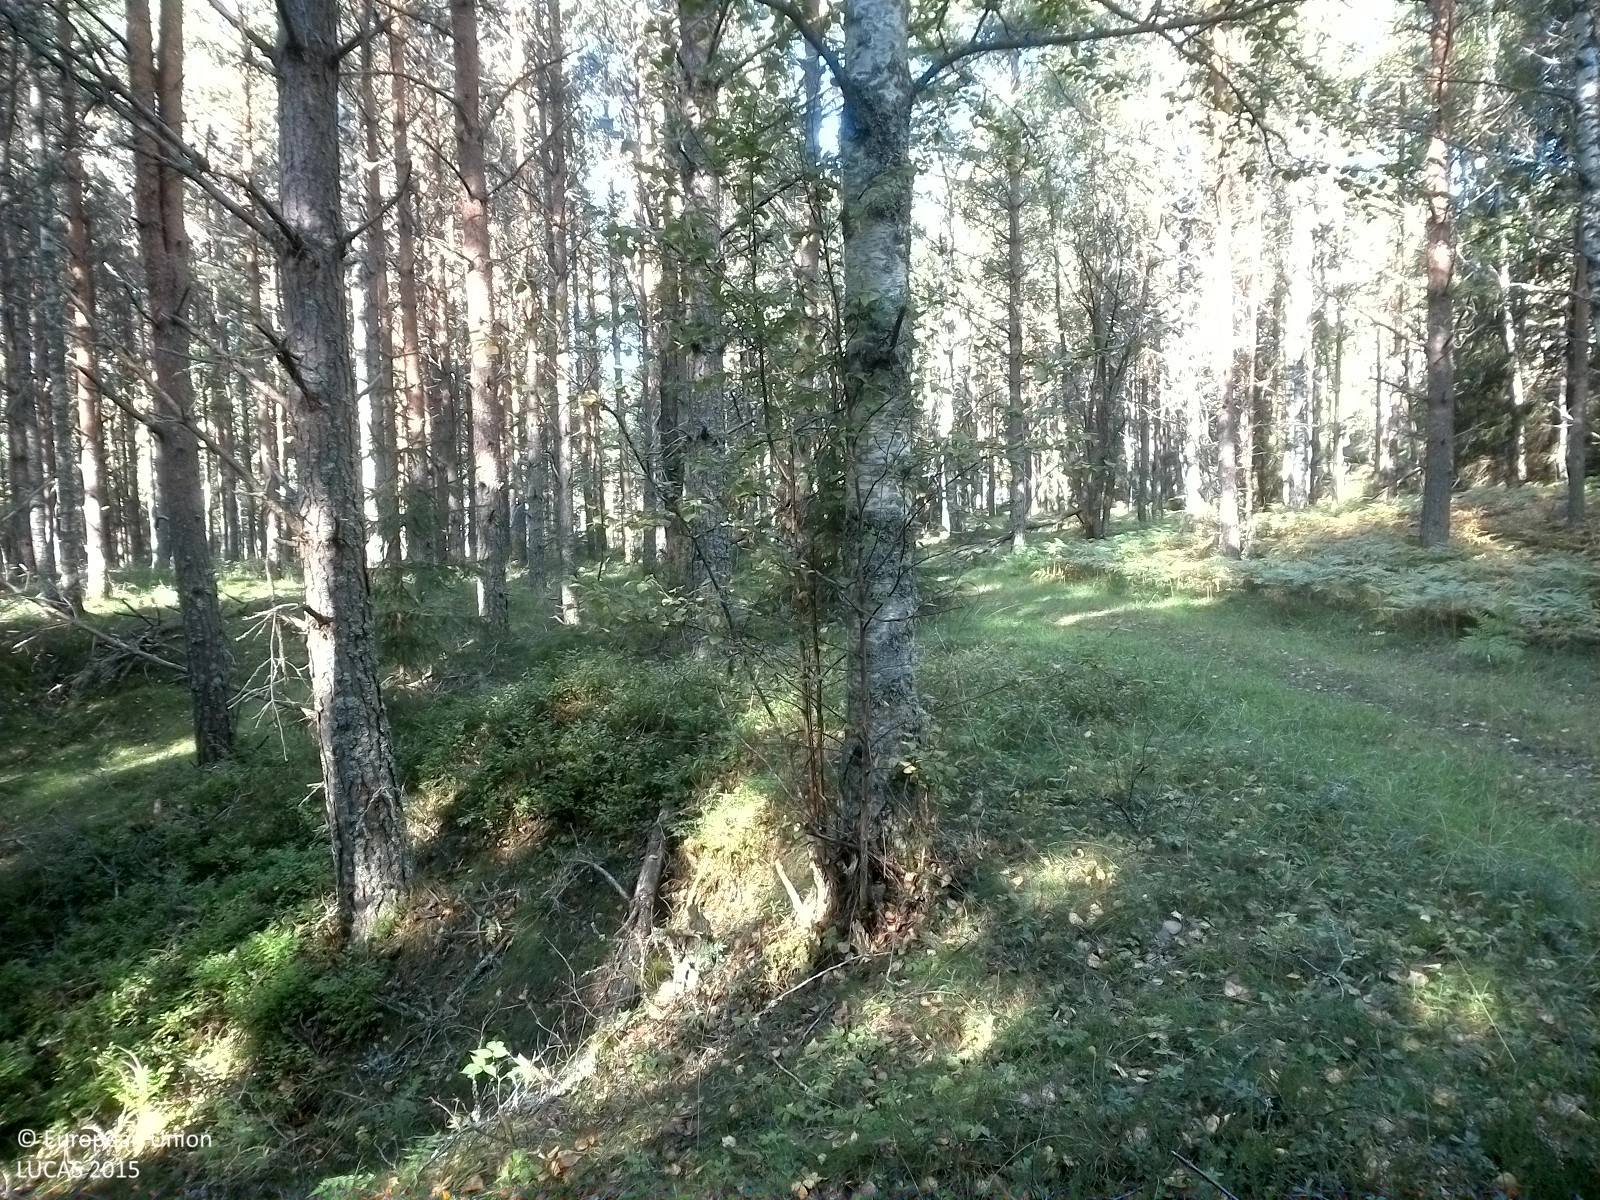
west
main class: Woodland
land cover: Pine dominated mixed woodland
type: boreal forest
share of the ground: 25 - 50 %
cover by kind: coniferous forest trees 30 %, lichens and mosses 30 %, herbaceous plants 25 %, broadleaved forest trees 15 %
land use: Forestry
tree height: > 5 m
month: September
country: SE
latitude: 59.0836
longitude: 15.8734
